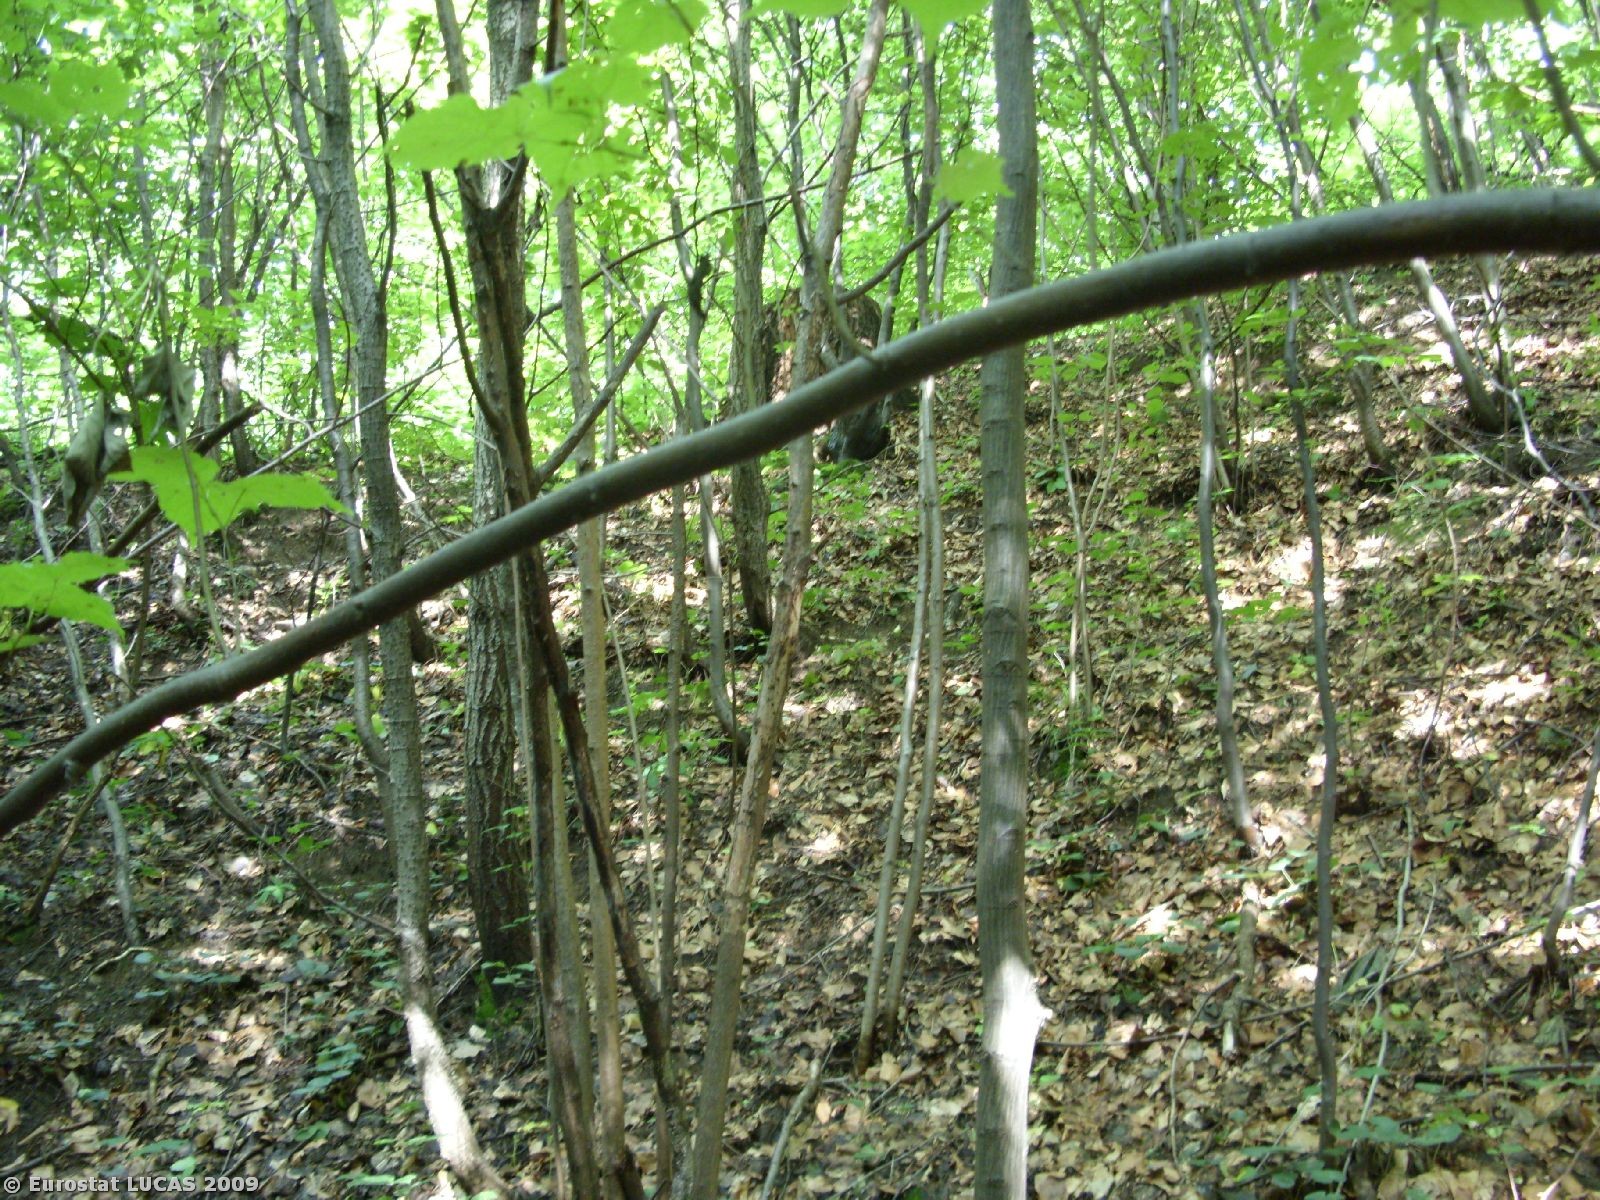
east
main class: Woodland
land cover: Broadleaved woodland
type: mesophytic deciduous forest
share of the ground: > 75 %
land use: Unused
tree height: > 5 m
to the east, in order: Broadleaved woodland; Tracks
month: June
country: PL
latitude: 49.8904
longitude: 20.1812
